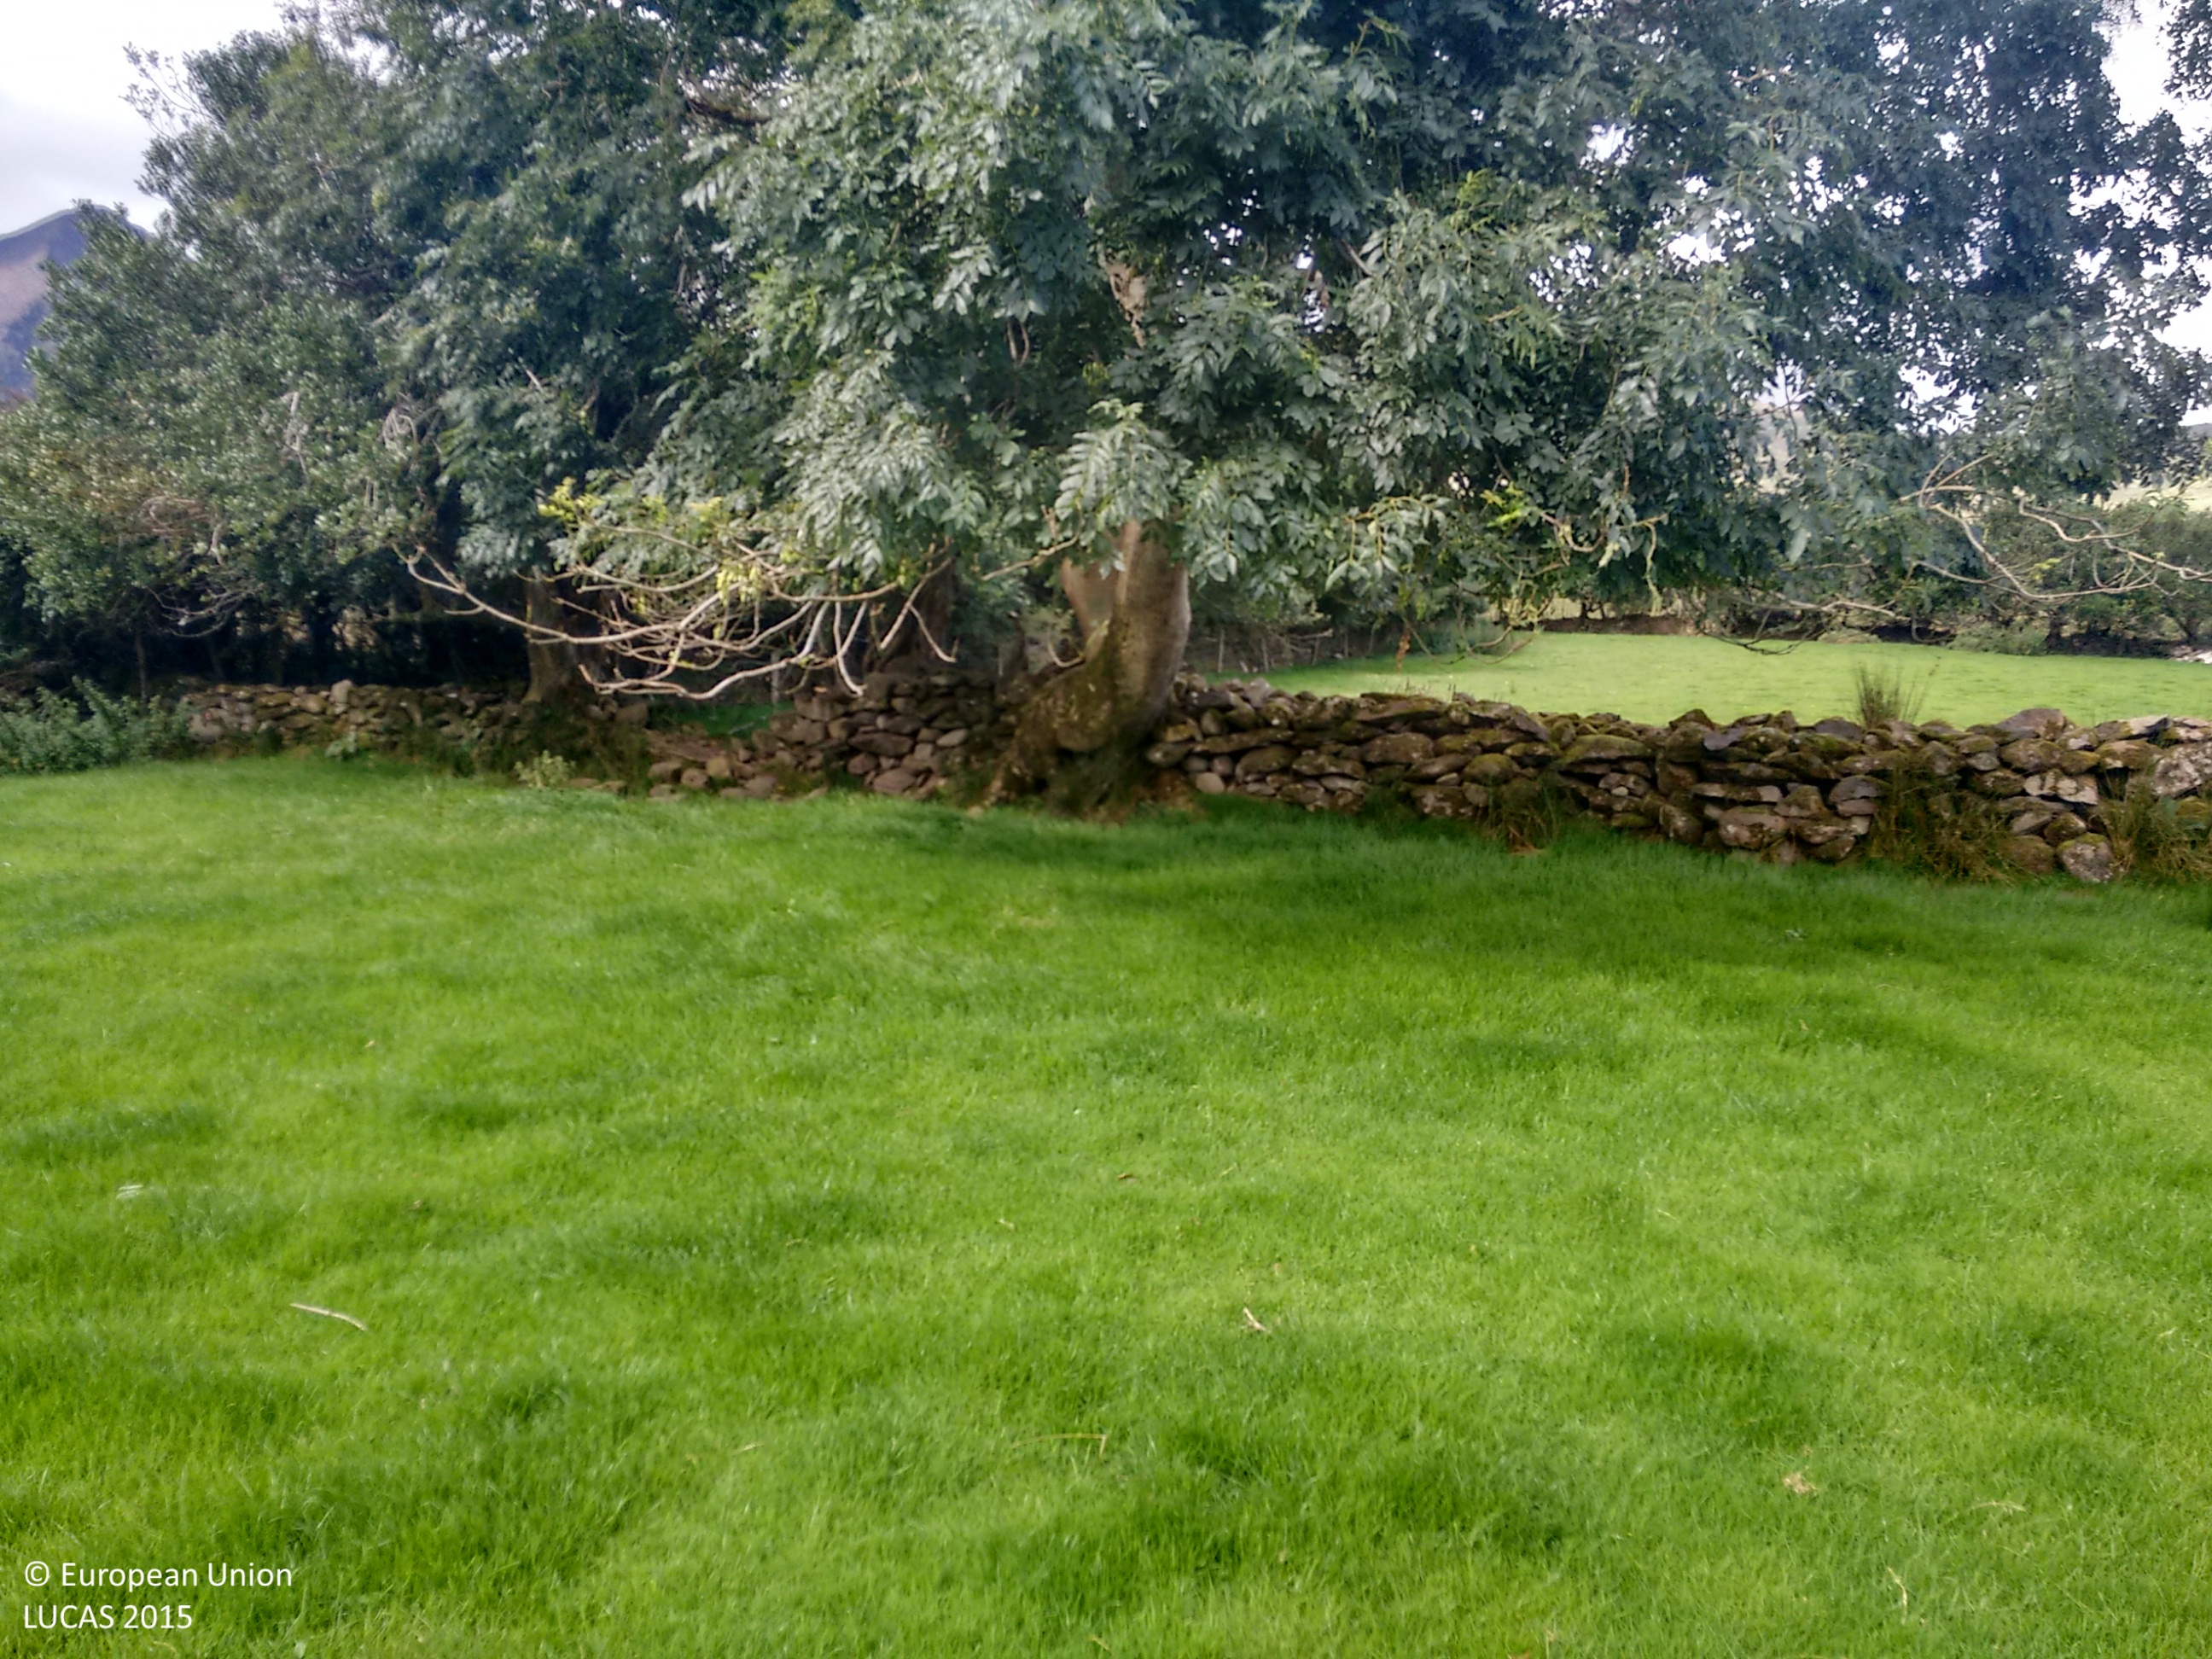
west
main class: Grassland
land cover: Grassland without tree/shrub cover
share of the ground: > 75 %
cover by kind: herbaceous plants 95 %, shrubs 5 %
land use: Agriculture (excluding fallow land and kitchen gardens)
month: September
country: IE
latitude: 52.2308
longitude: -10.1893
